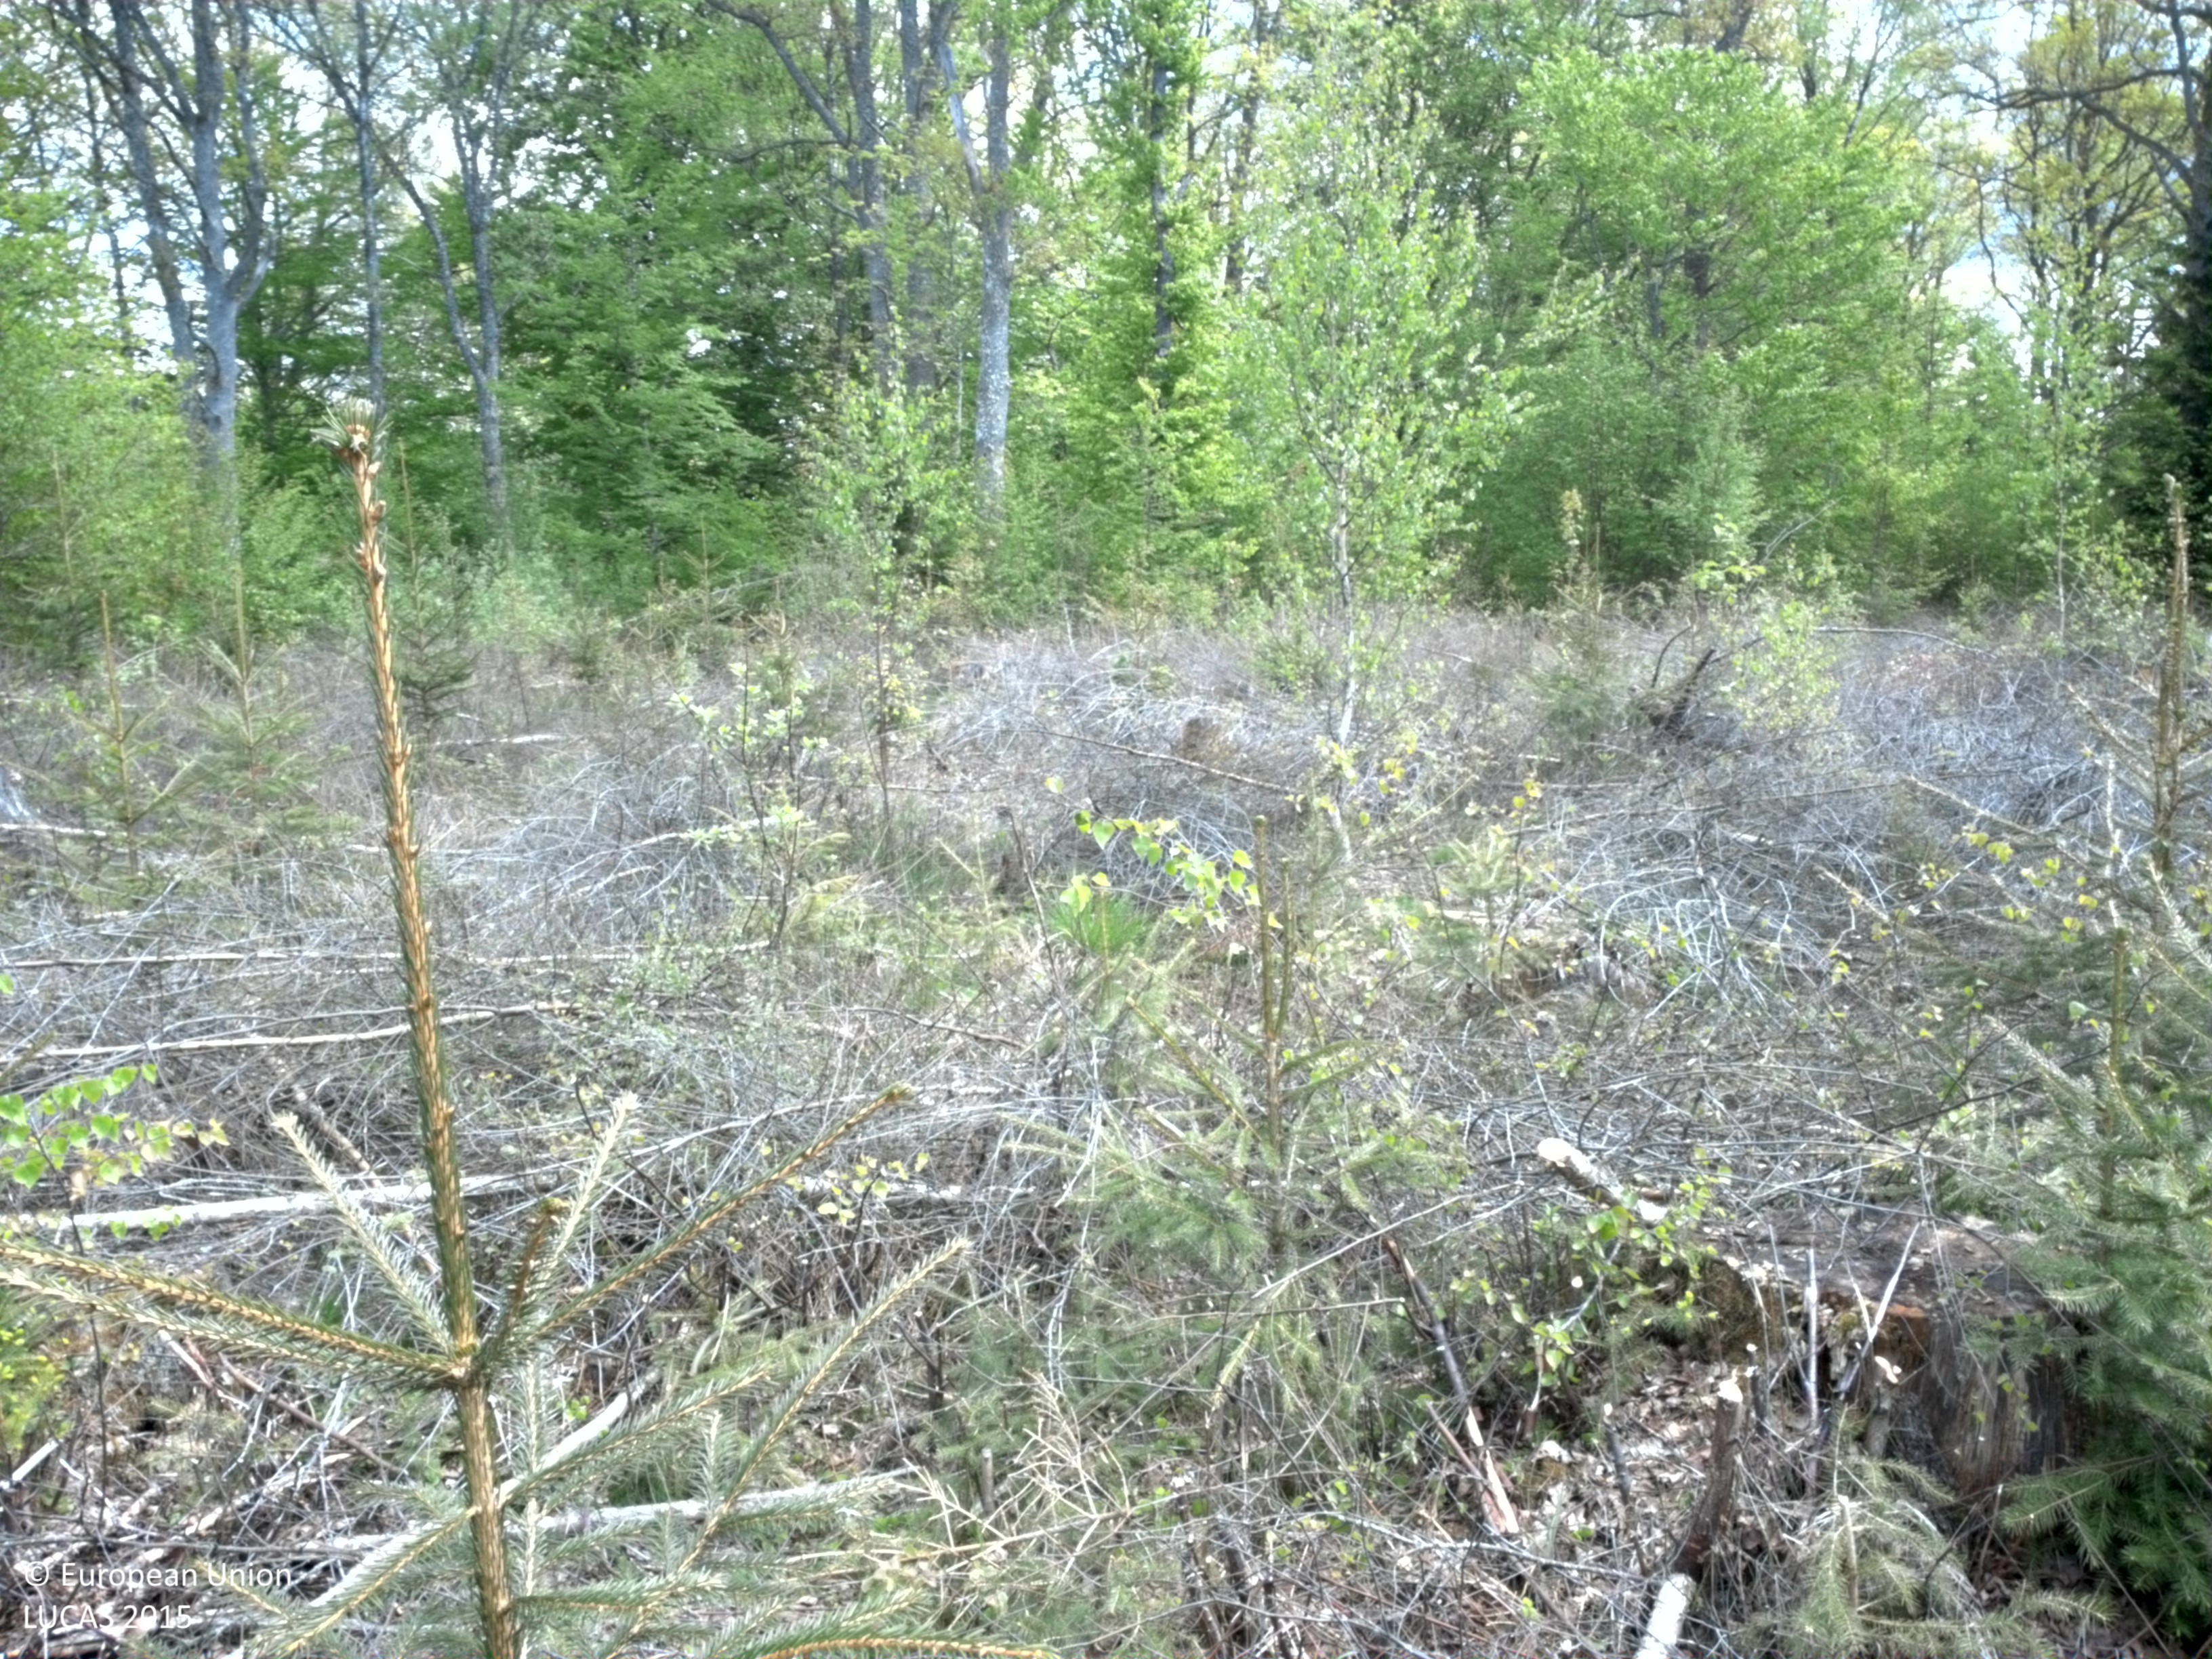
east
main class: Woodland
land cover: Spruce dominated mixed woodland
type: boreal forest
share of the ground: 25 - 50 %
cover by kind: coniferous forest trees 30 %, herbaceous plants 20 %, broadleaved forest trees 10 %, shrubs 10 %, unconsolidated bare surface 10 %
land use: Forestry
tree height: < 5 m
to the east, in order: Spruce dominated mixed woodland; Broadleaved woodland; Tracks; Broadleaved woodland; Dry stone walls; Grassland with sparse tree/shrub cover; Broadleaved woodland; Grass margins; Other bare soil; Electric lines; Grass margins; Paved roads, cycling and walking lanes; Ditches and canals; Rye; Electric lines; Rye
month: May
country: SE
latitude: 56.5296
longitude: 15.2824
